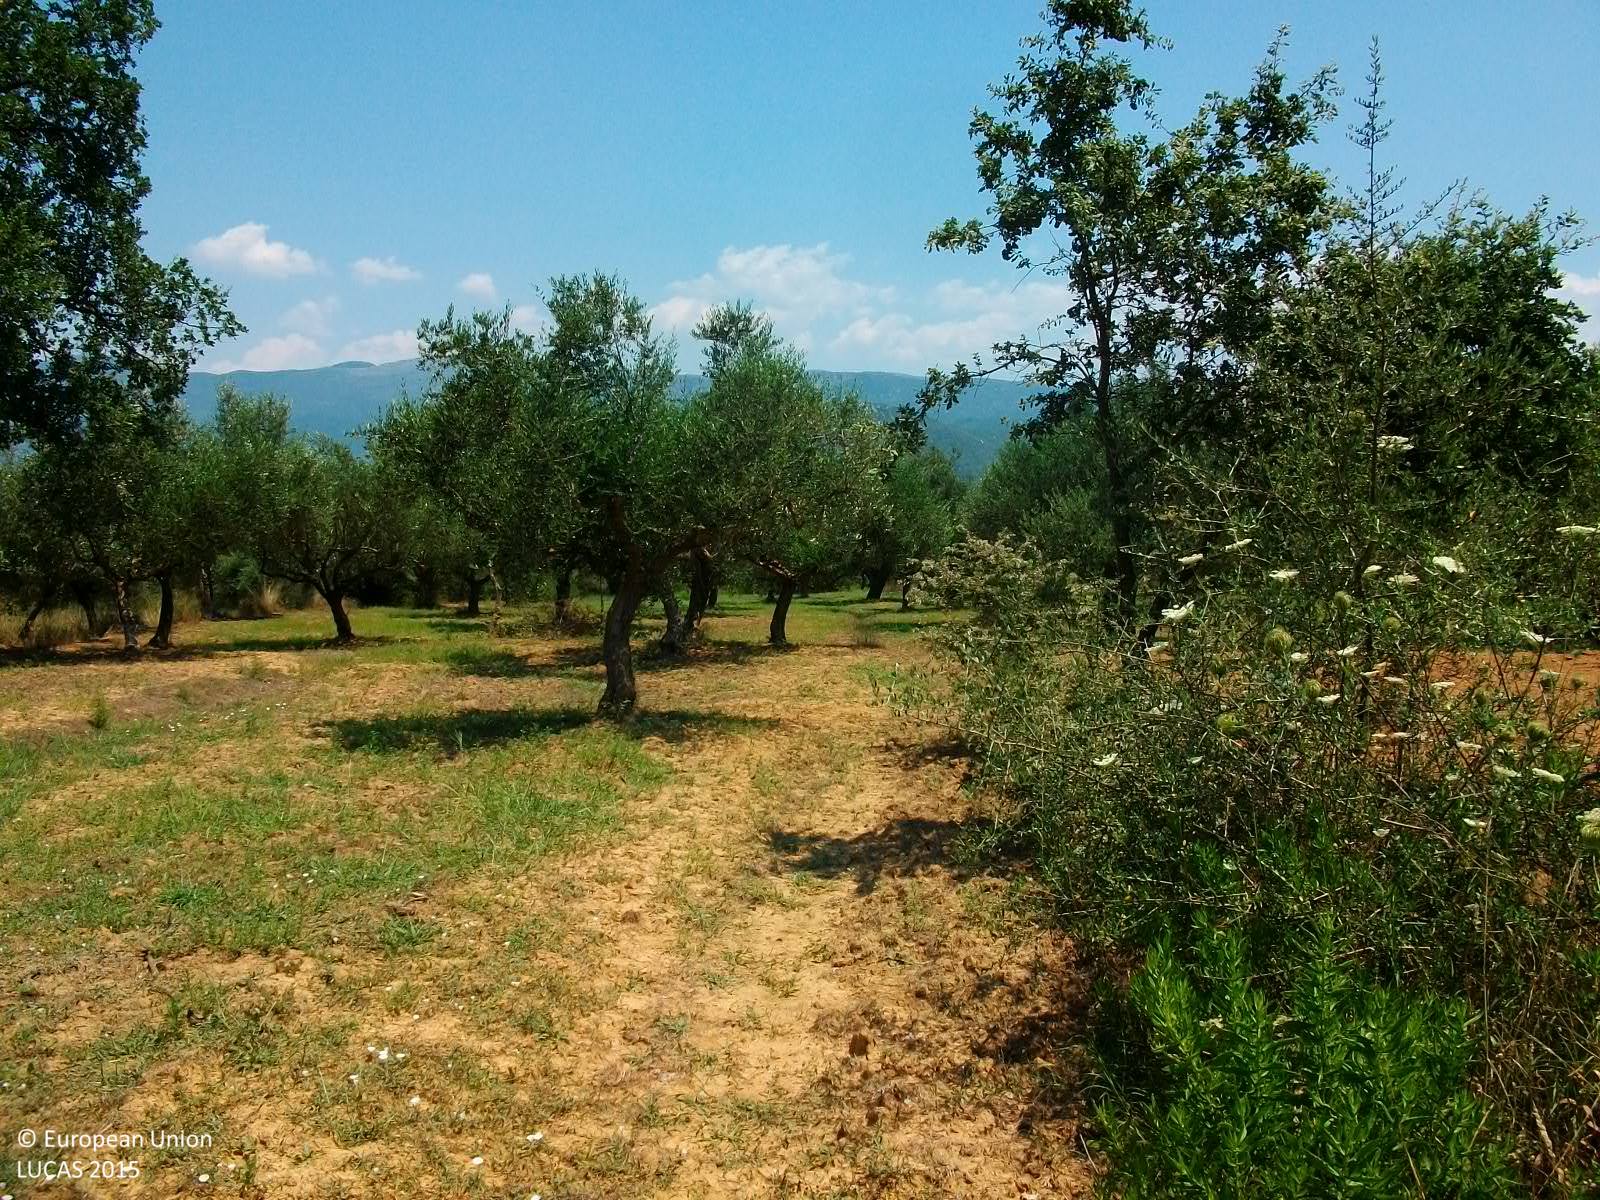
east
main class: Cropland
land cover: Olive groves
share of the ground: < 10 %
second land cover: Spontaneously vegetated surfaces
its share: > 75 %
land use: Agriculture (excluding fallow land and kitchen gardens)
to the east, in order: Abandoned hedges; Olive groves; Spontaneously vegetated surfaces; Ditches and canals; Olive groves; Broadleaved woodland; Grassland with sparse tree/shrub cover; Spontaneously vegetated surfaces; Shruby margins; Tracks
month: July
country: GR
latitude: 37.2073
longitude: 21.9778
